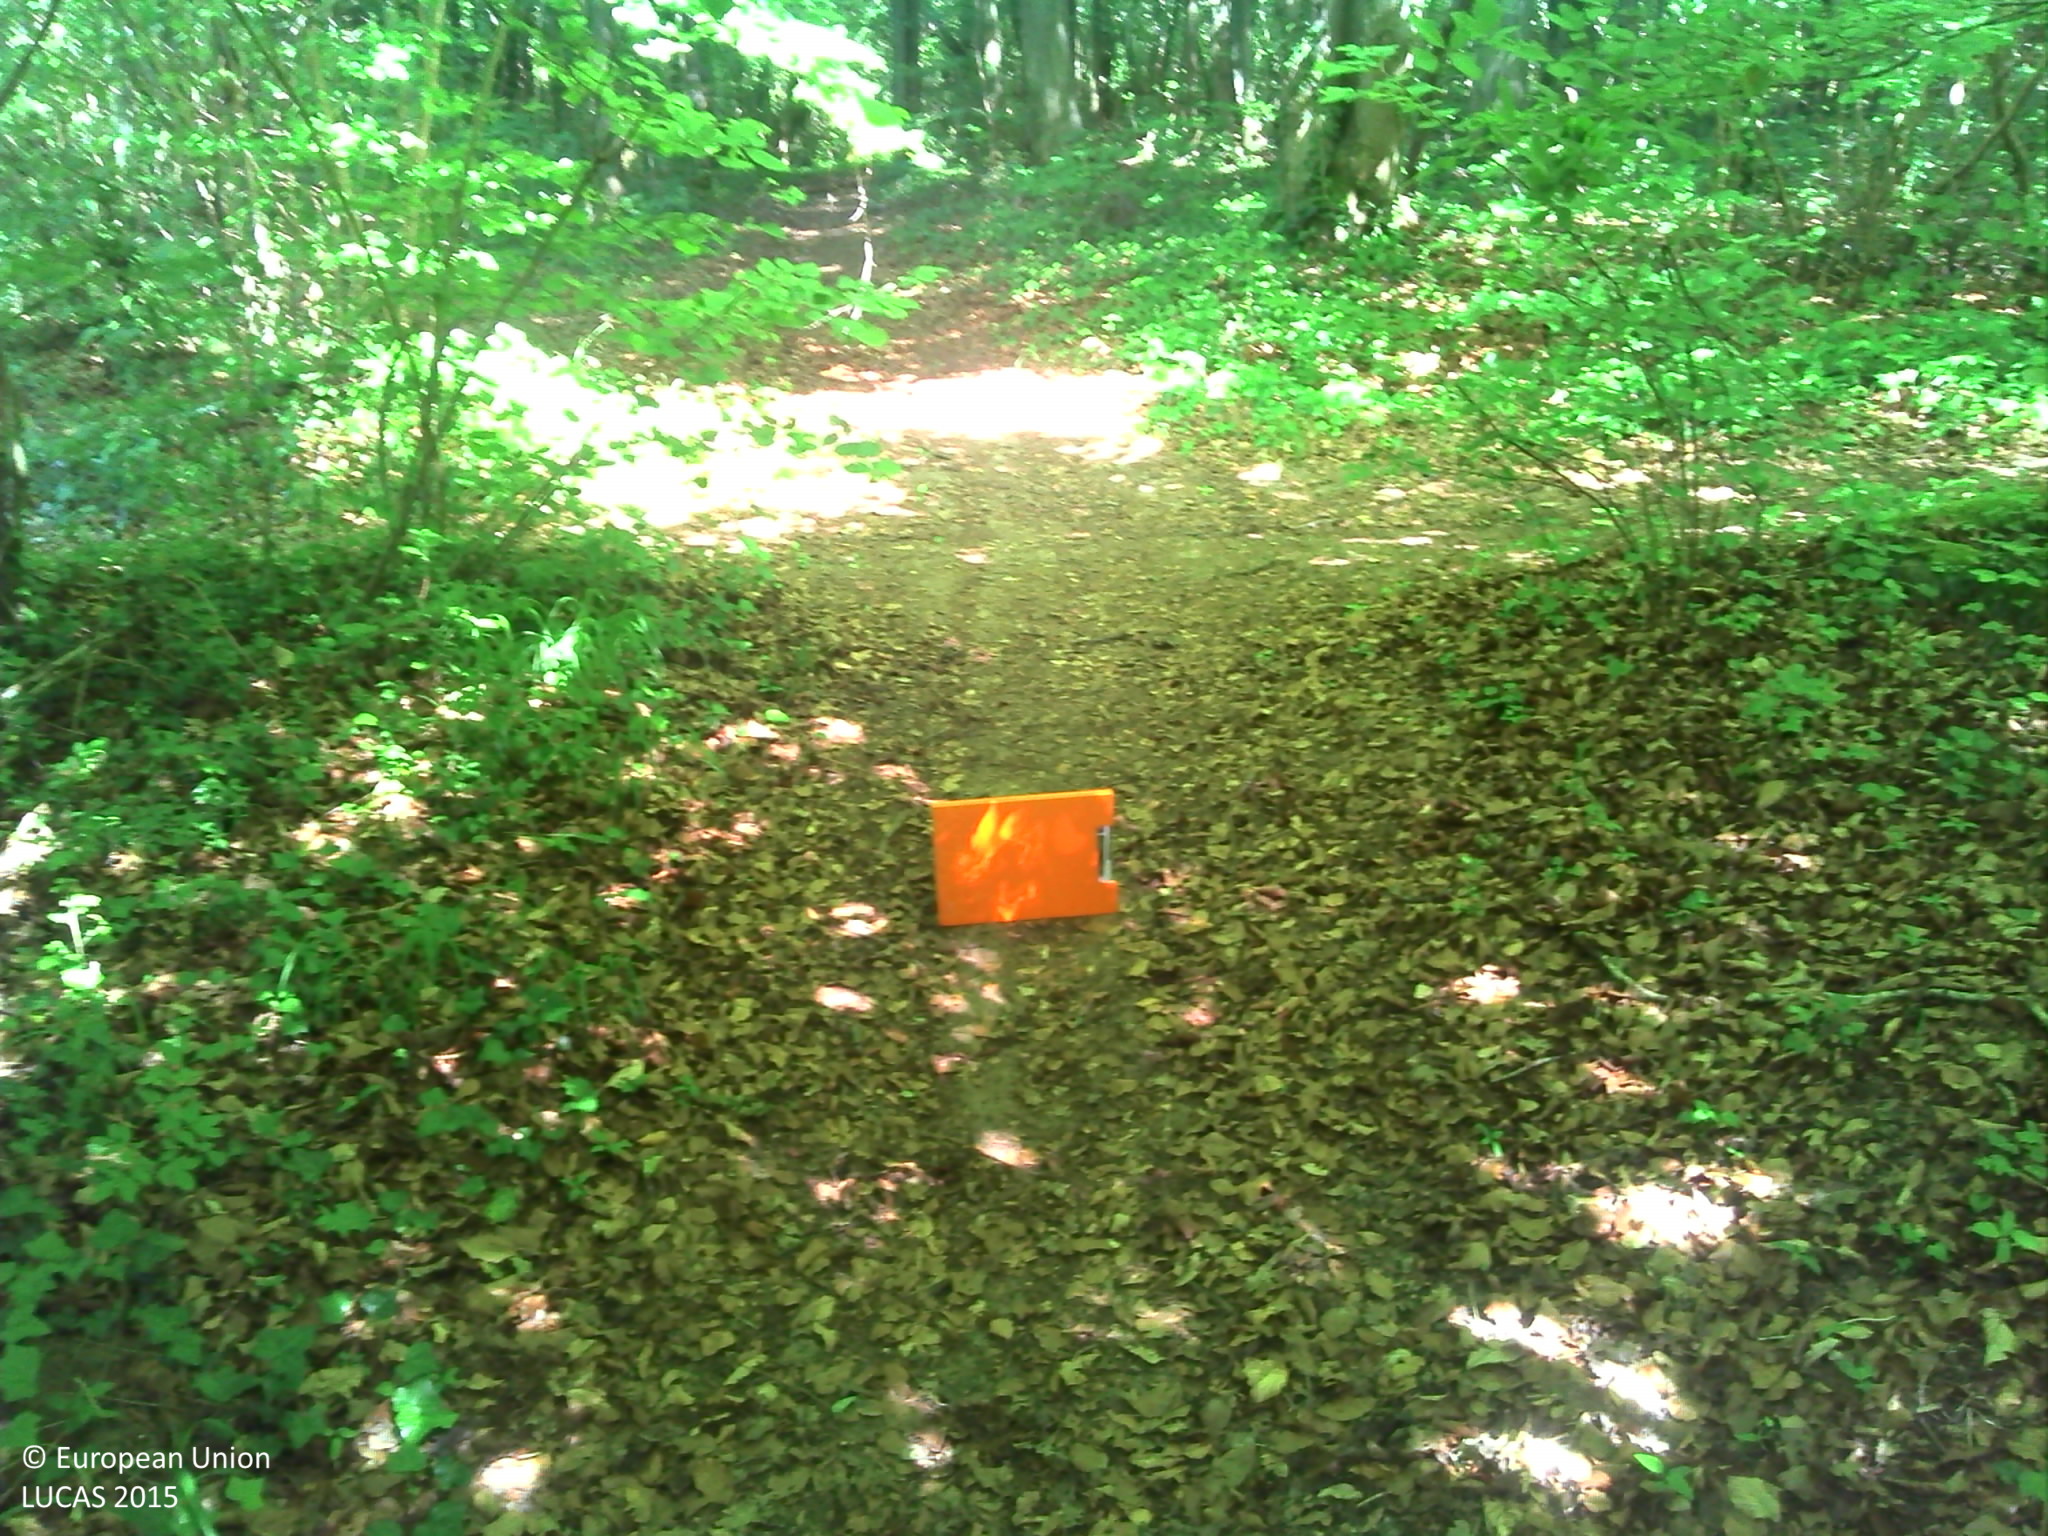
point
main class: Woodland
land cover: Broadleaved woodland
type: beech forest
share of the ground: > 75 %
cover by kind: broadleaved forest trees 90 %, coniferous forest trees 10 %
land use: Forestry
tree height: > 5 m
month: June
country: FR
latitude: 49.4085
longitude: 3.2800
